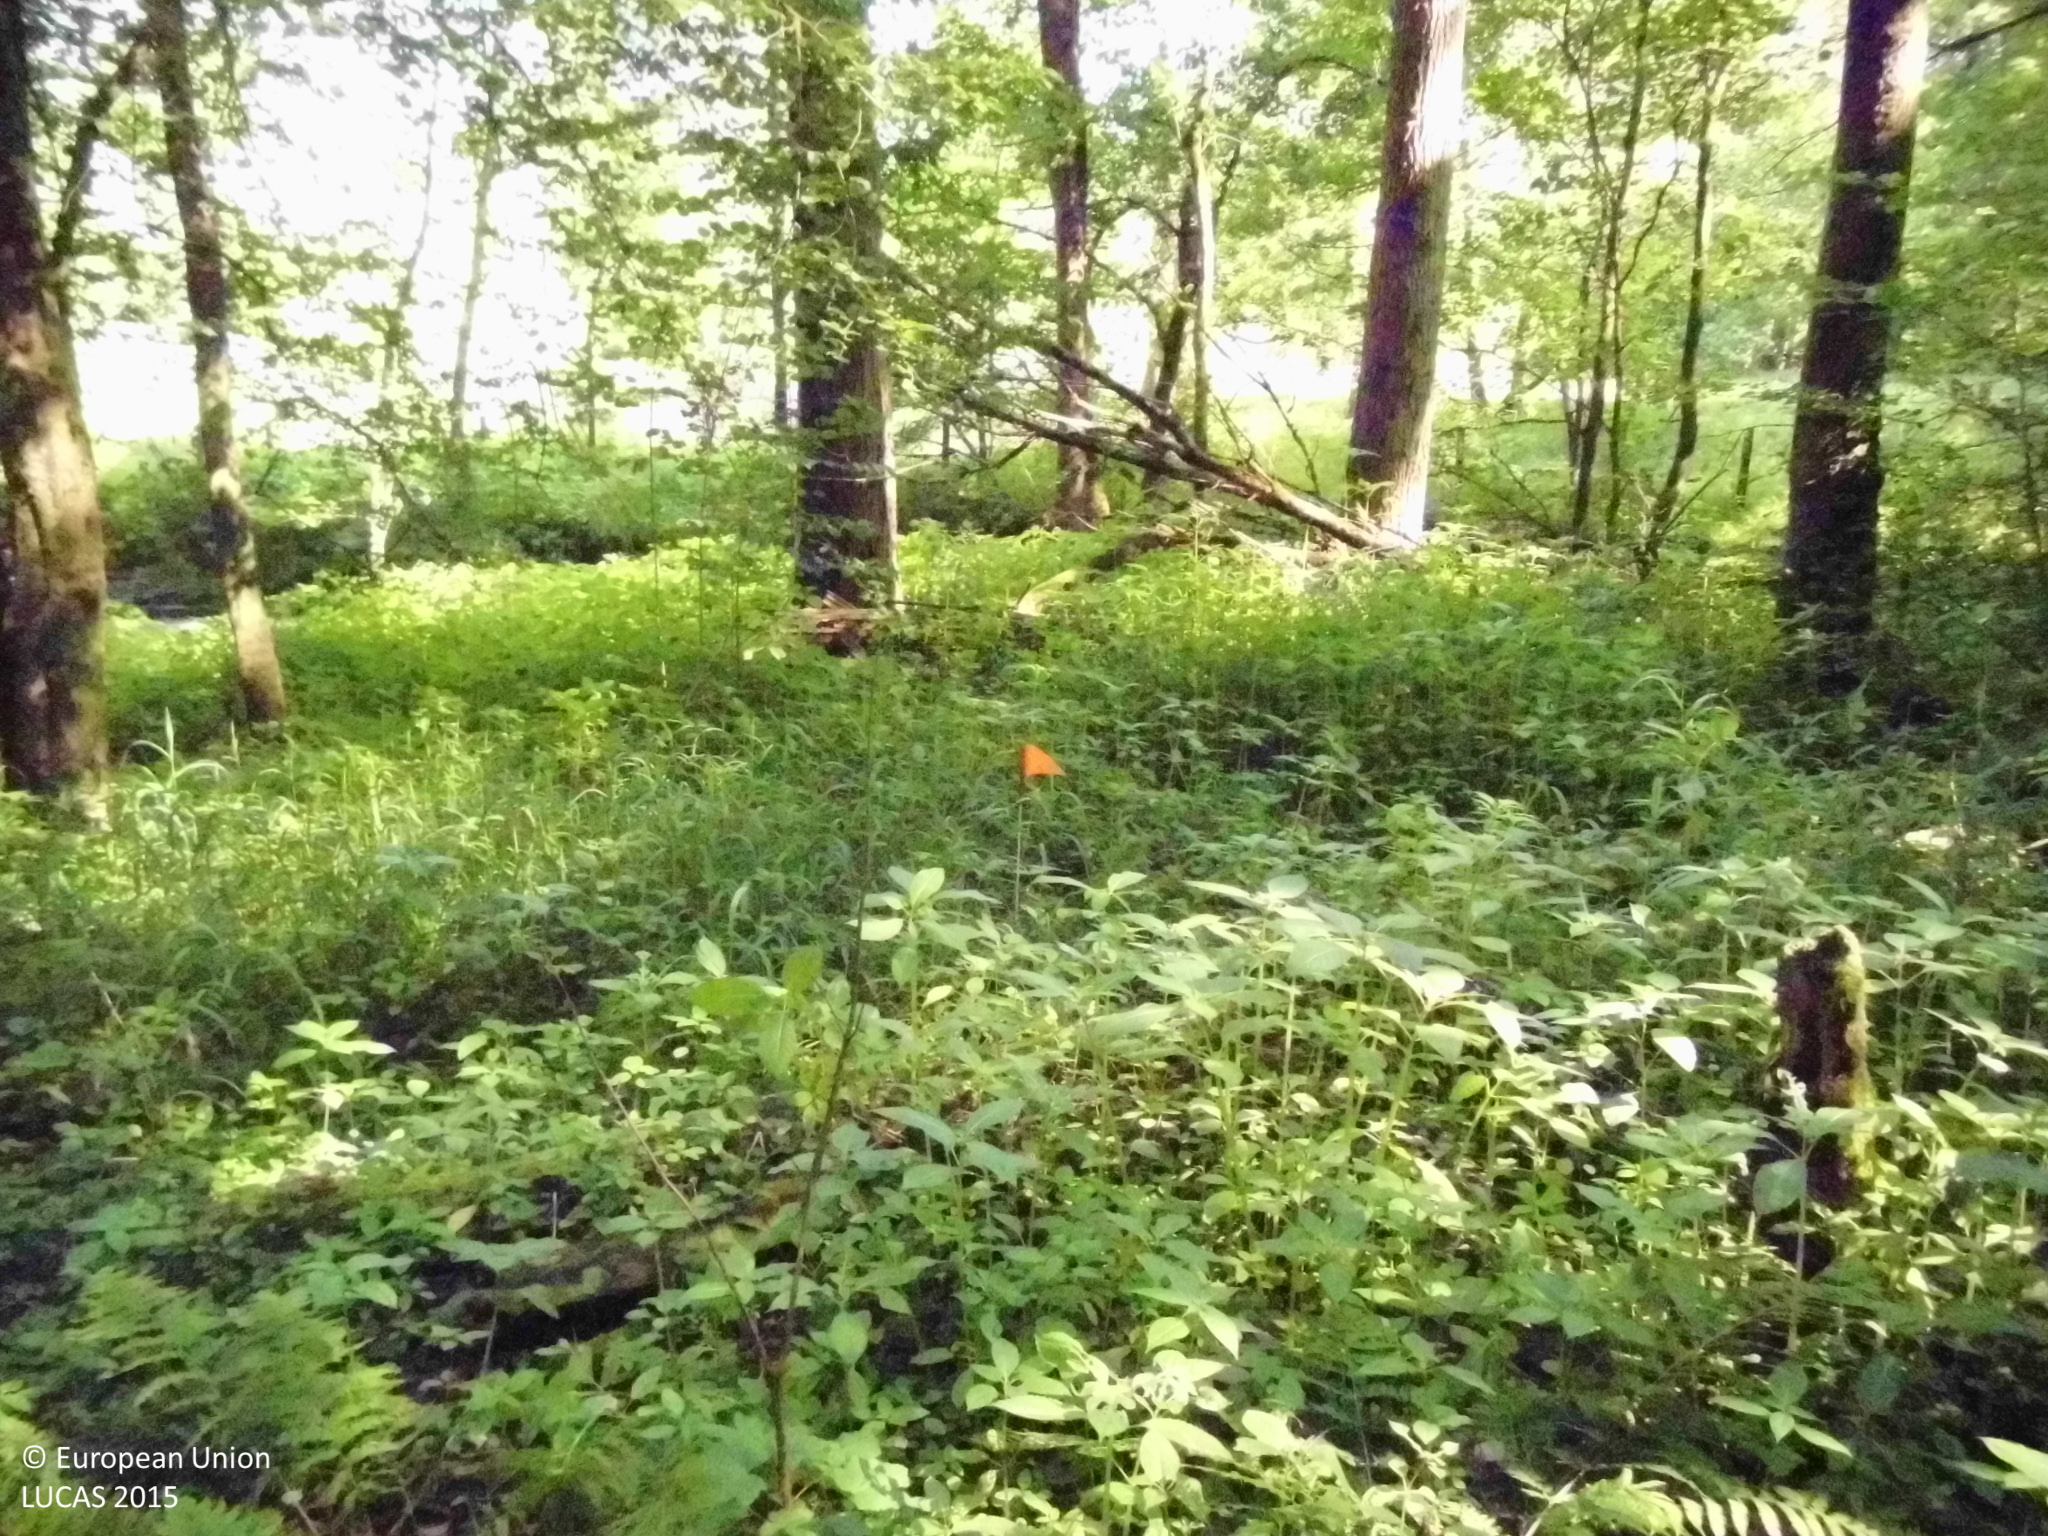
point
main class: Woodland
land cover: Broadleaved woodland
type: mesophytic deciduous forest
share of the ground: > 75 %
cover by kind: broadleaved forest trees 85 %, herbaceous plants 15 %
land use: Forestry
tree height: > 5 m
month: June
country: DE
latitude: 50.9108
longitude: 7.4260
